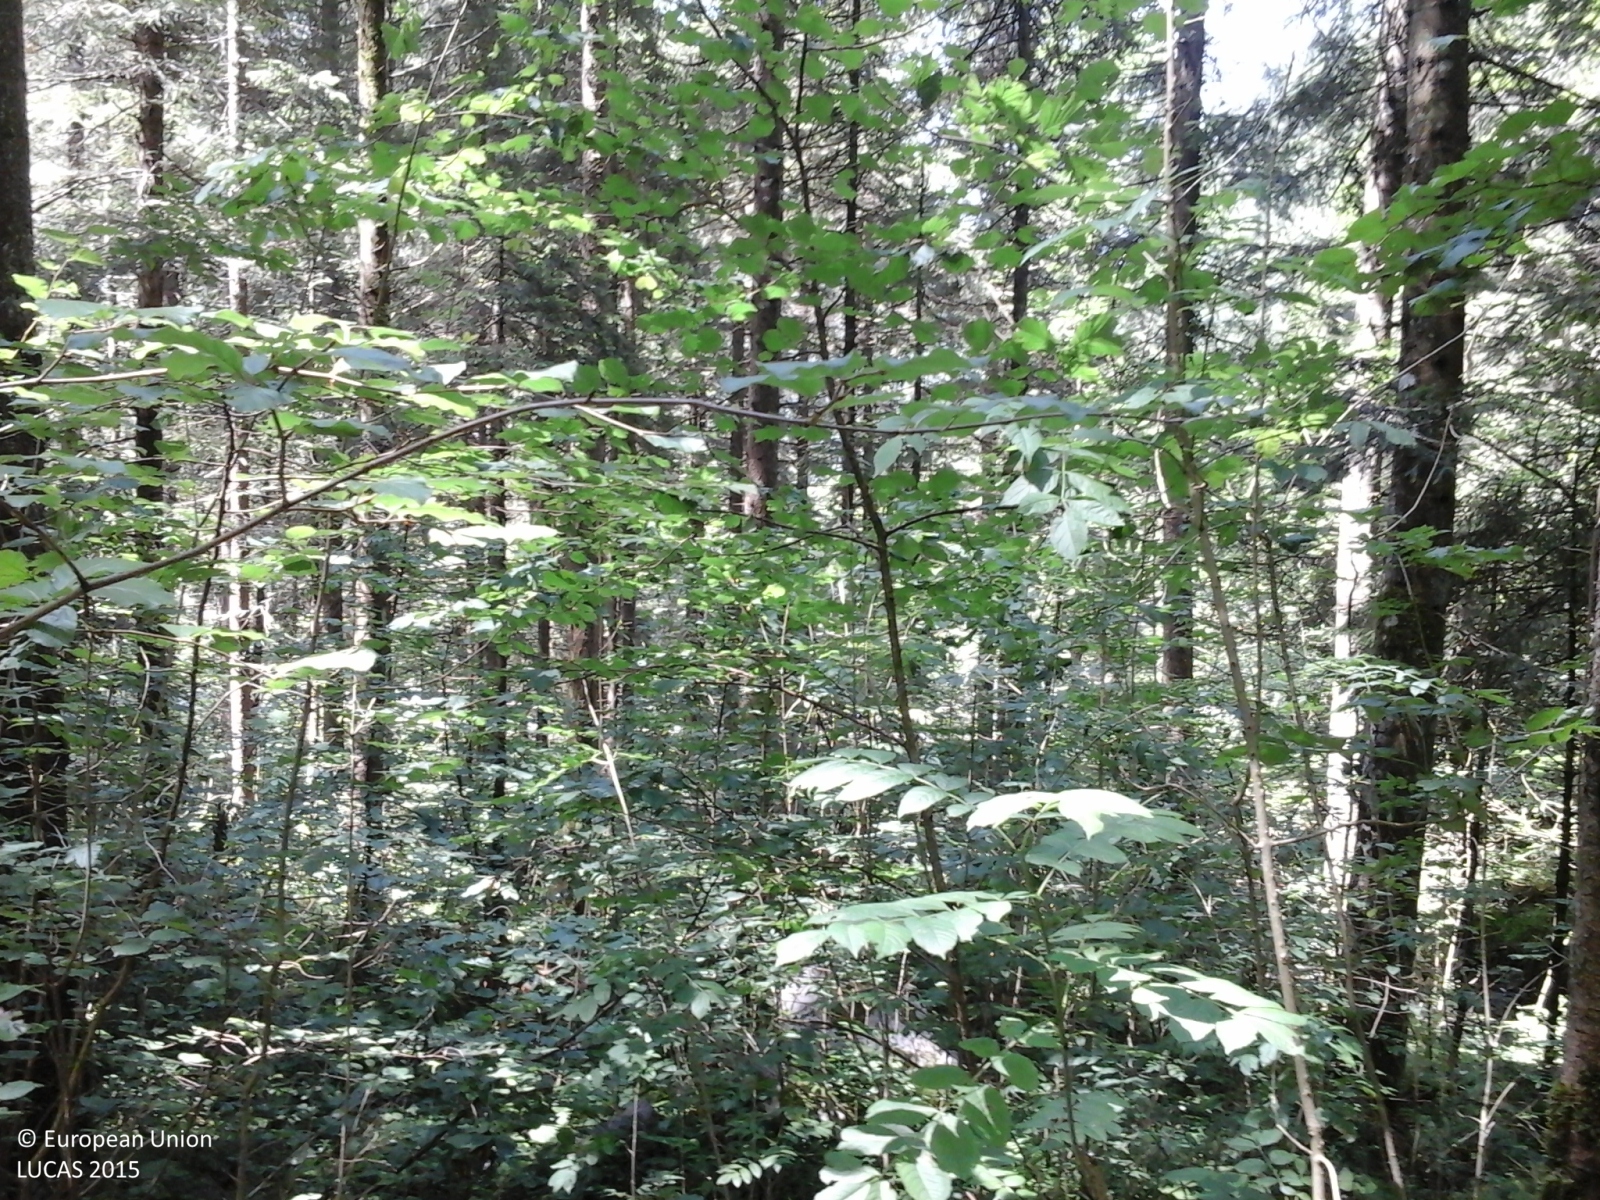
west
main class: Woodland
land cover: Spruce dominated mixed woodland
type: alpine coniferous forest
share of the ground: > 75 %
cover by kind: coniferous forest trees 75 %, broadleaved forest trees 25 %
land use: Semi-natural and natural areas not in use
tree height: > 5 m
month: July
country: IT
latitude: 45.9728
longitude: 10.1160
